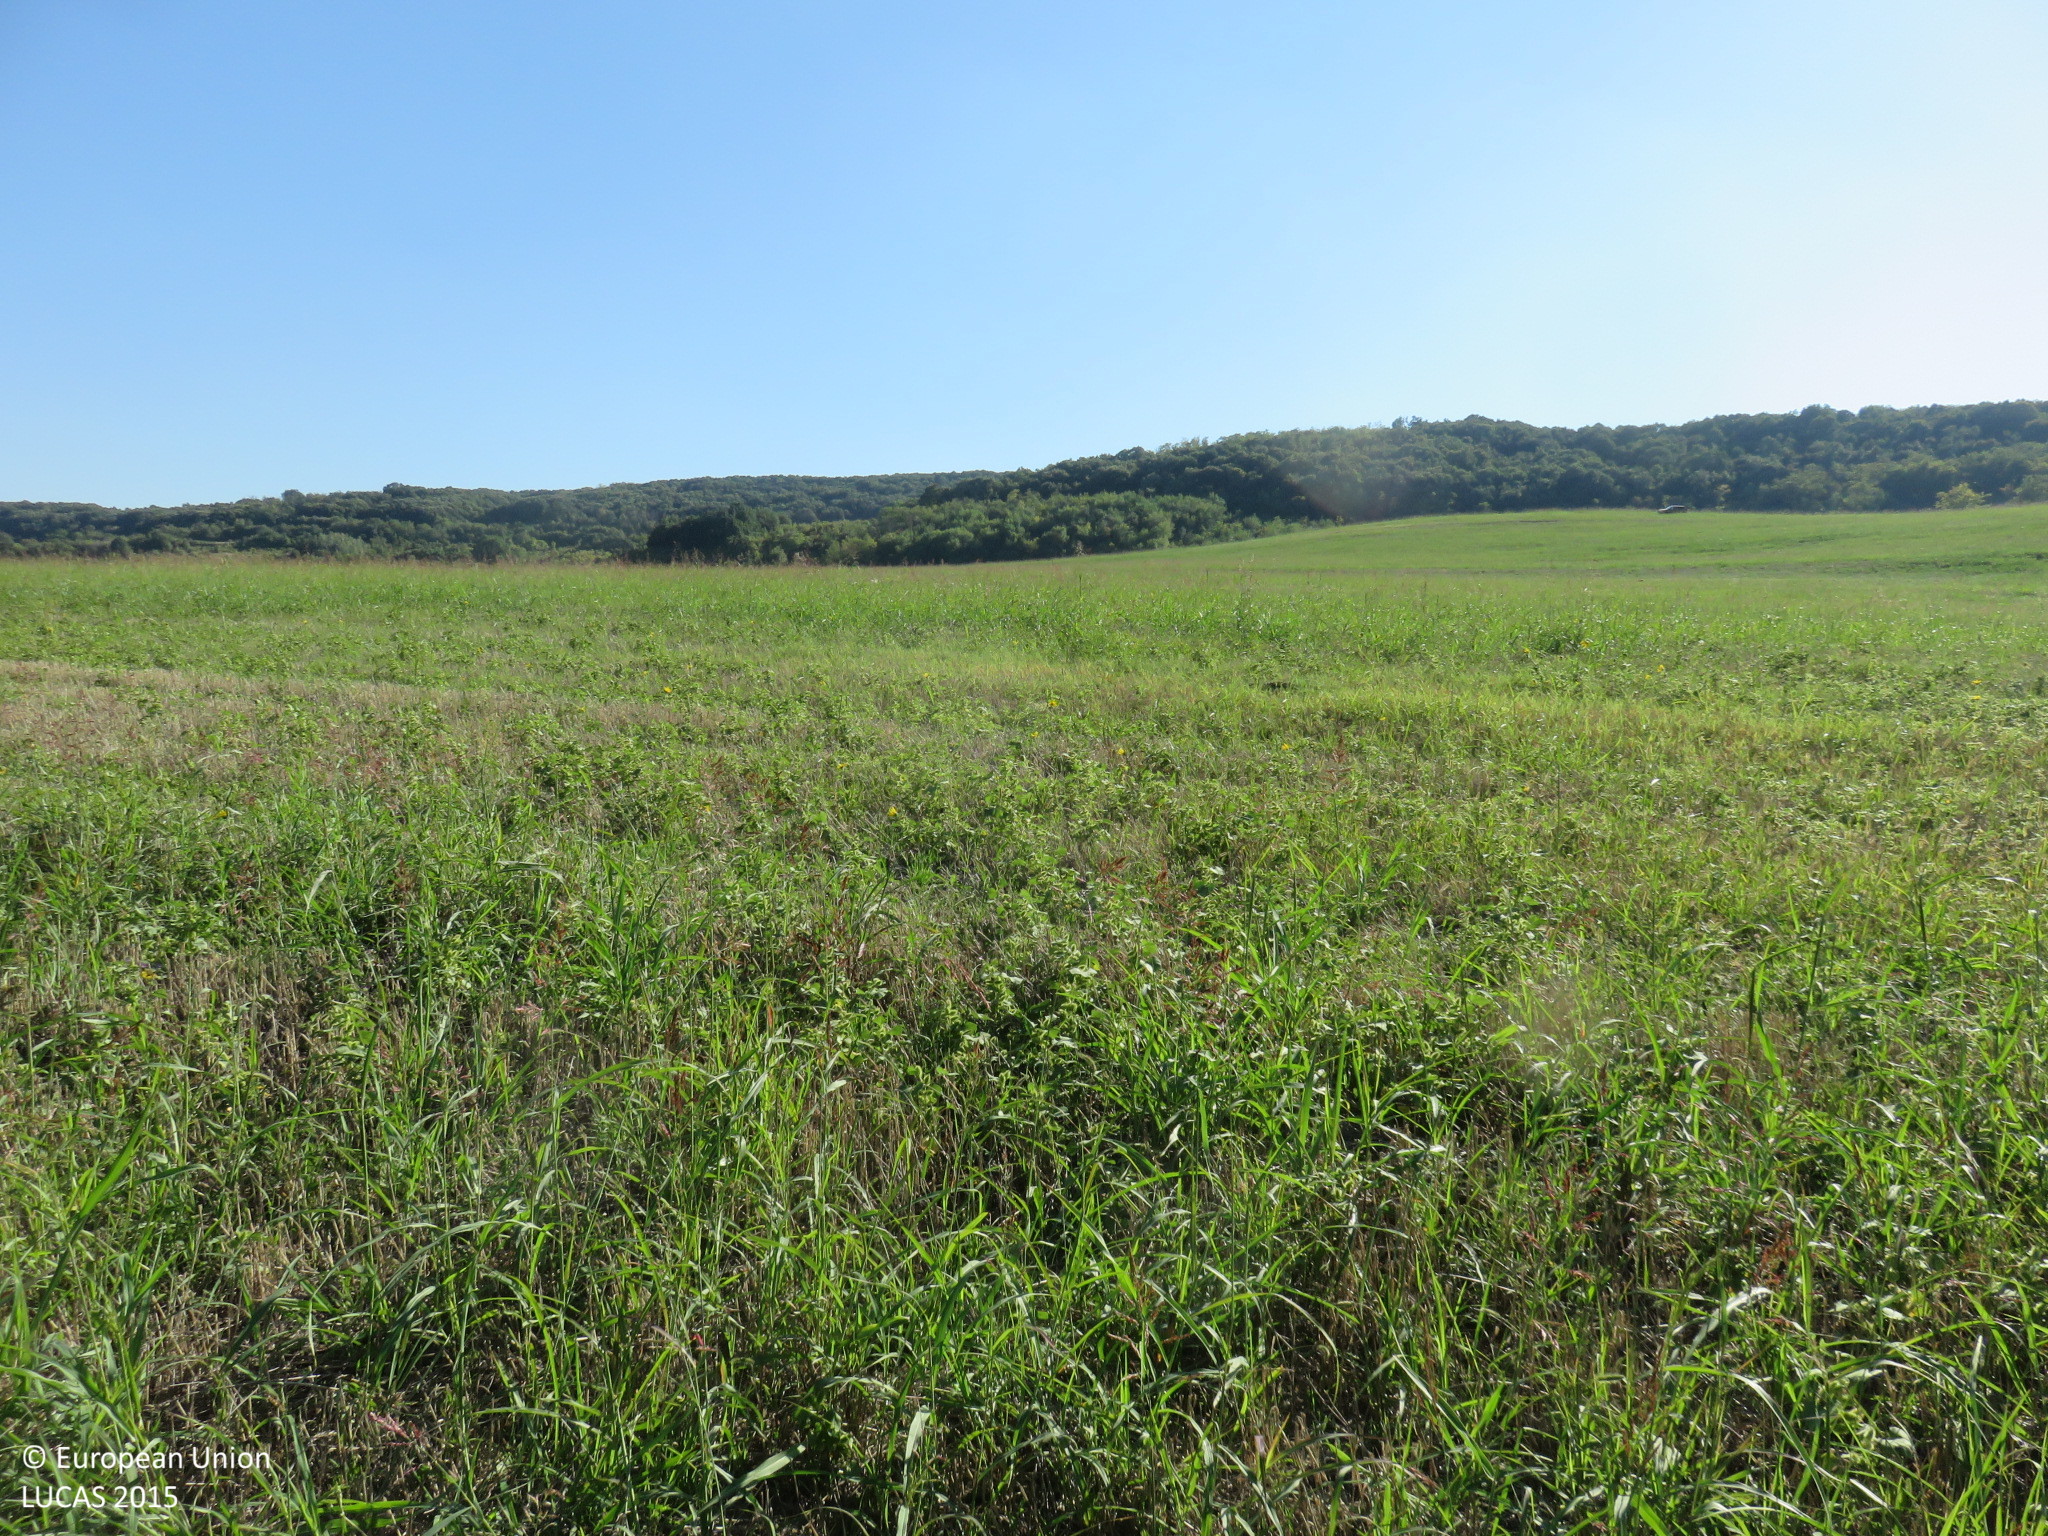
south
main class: Cropland
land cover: Common wheat
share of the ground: < 10 %
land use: Agriculture (excluding fallow land and kitchen gardens)
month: September
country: BG
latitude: 43.6752
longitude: 24.9942
